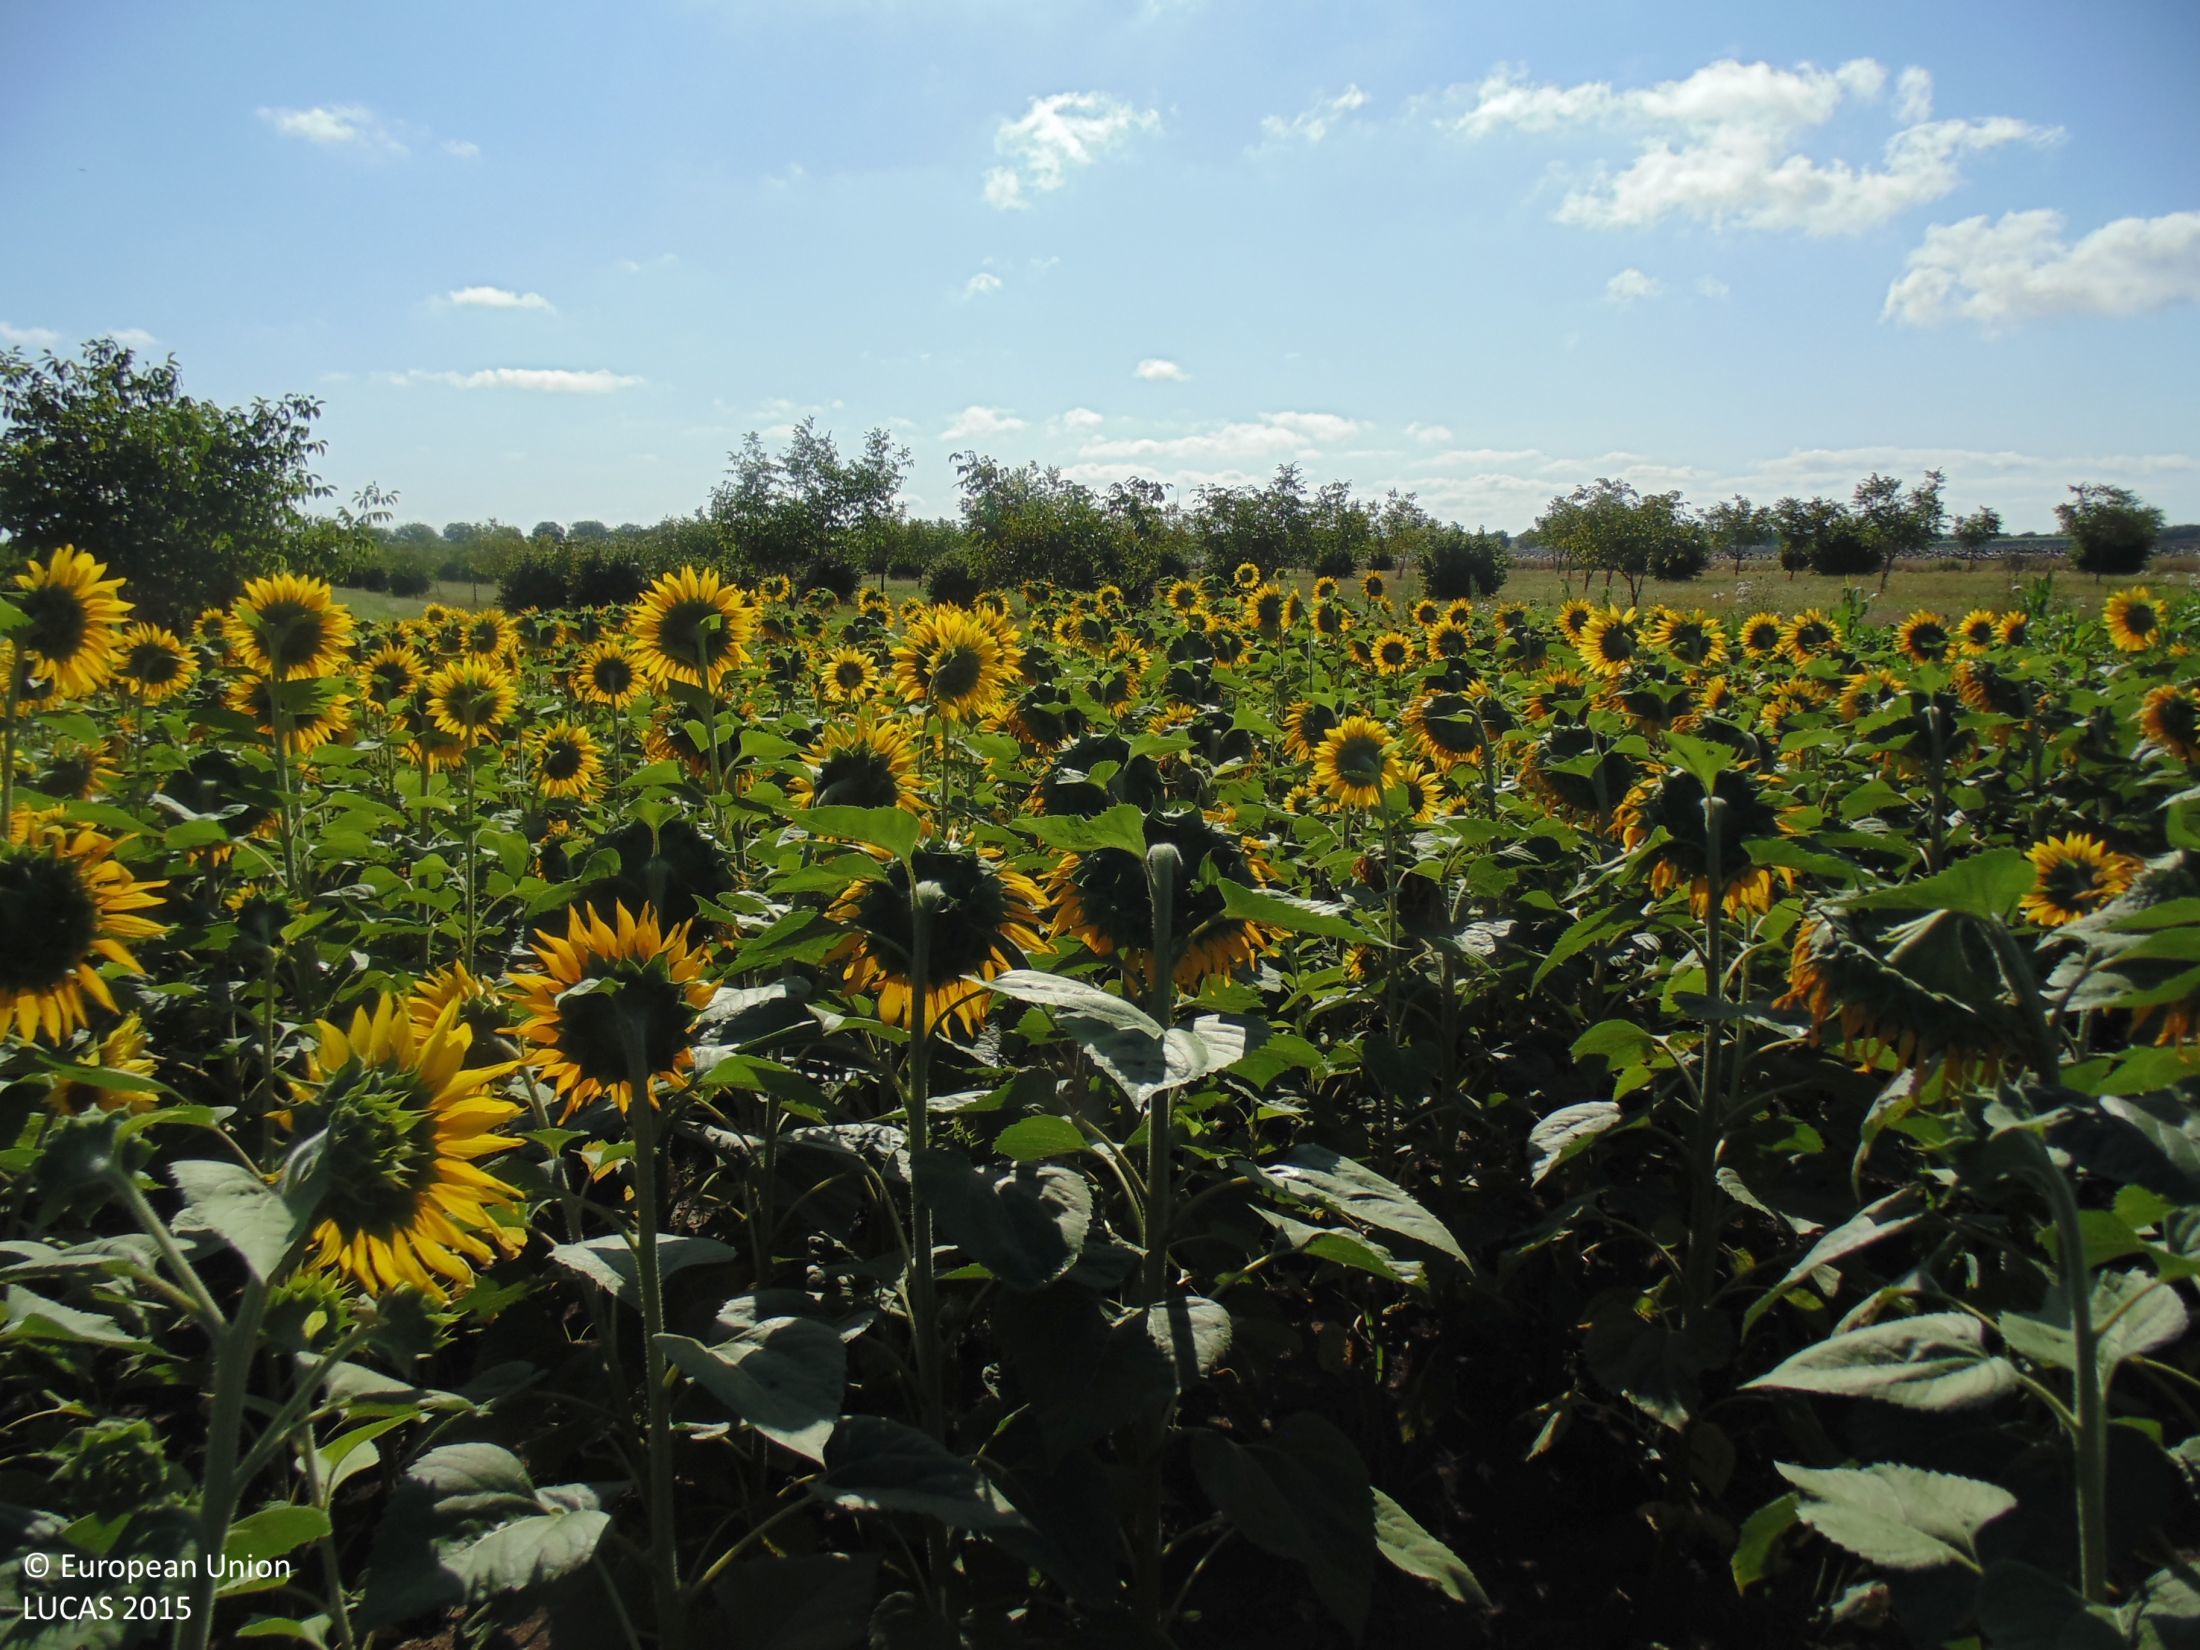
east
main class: Cropland
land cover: Sunflower
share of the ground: > 75 %
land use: Agriculture (excluding fallow land and kitchen gardens)
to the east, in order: Sunflower; Grass margins; Nuts trees
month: July
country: BG
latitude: 43.4561
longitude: 27.9267
